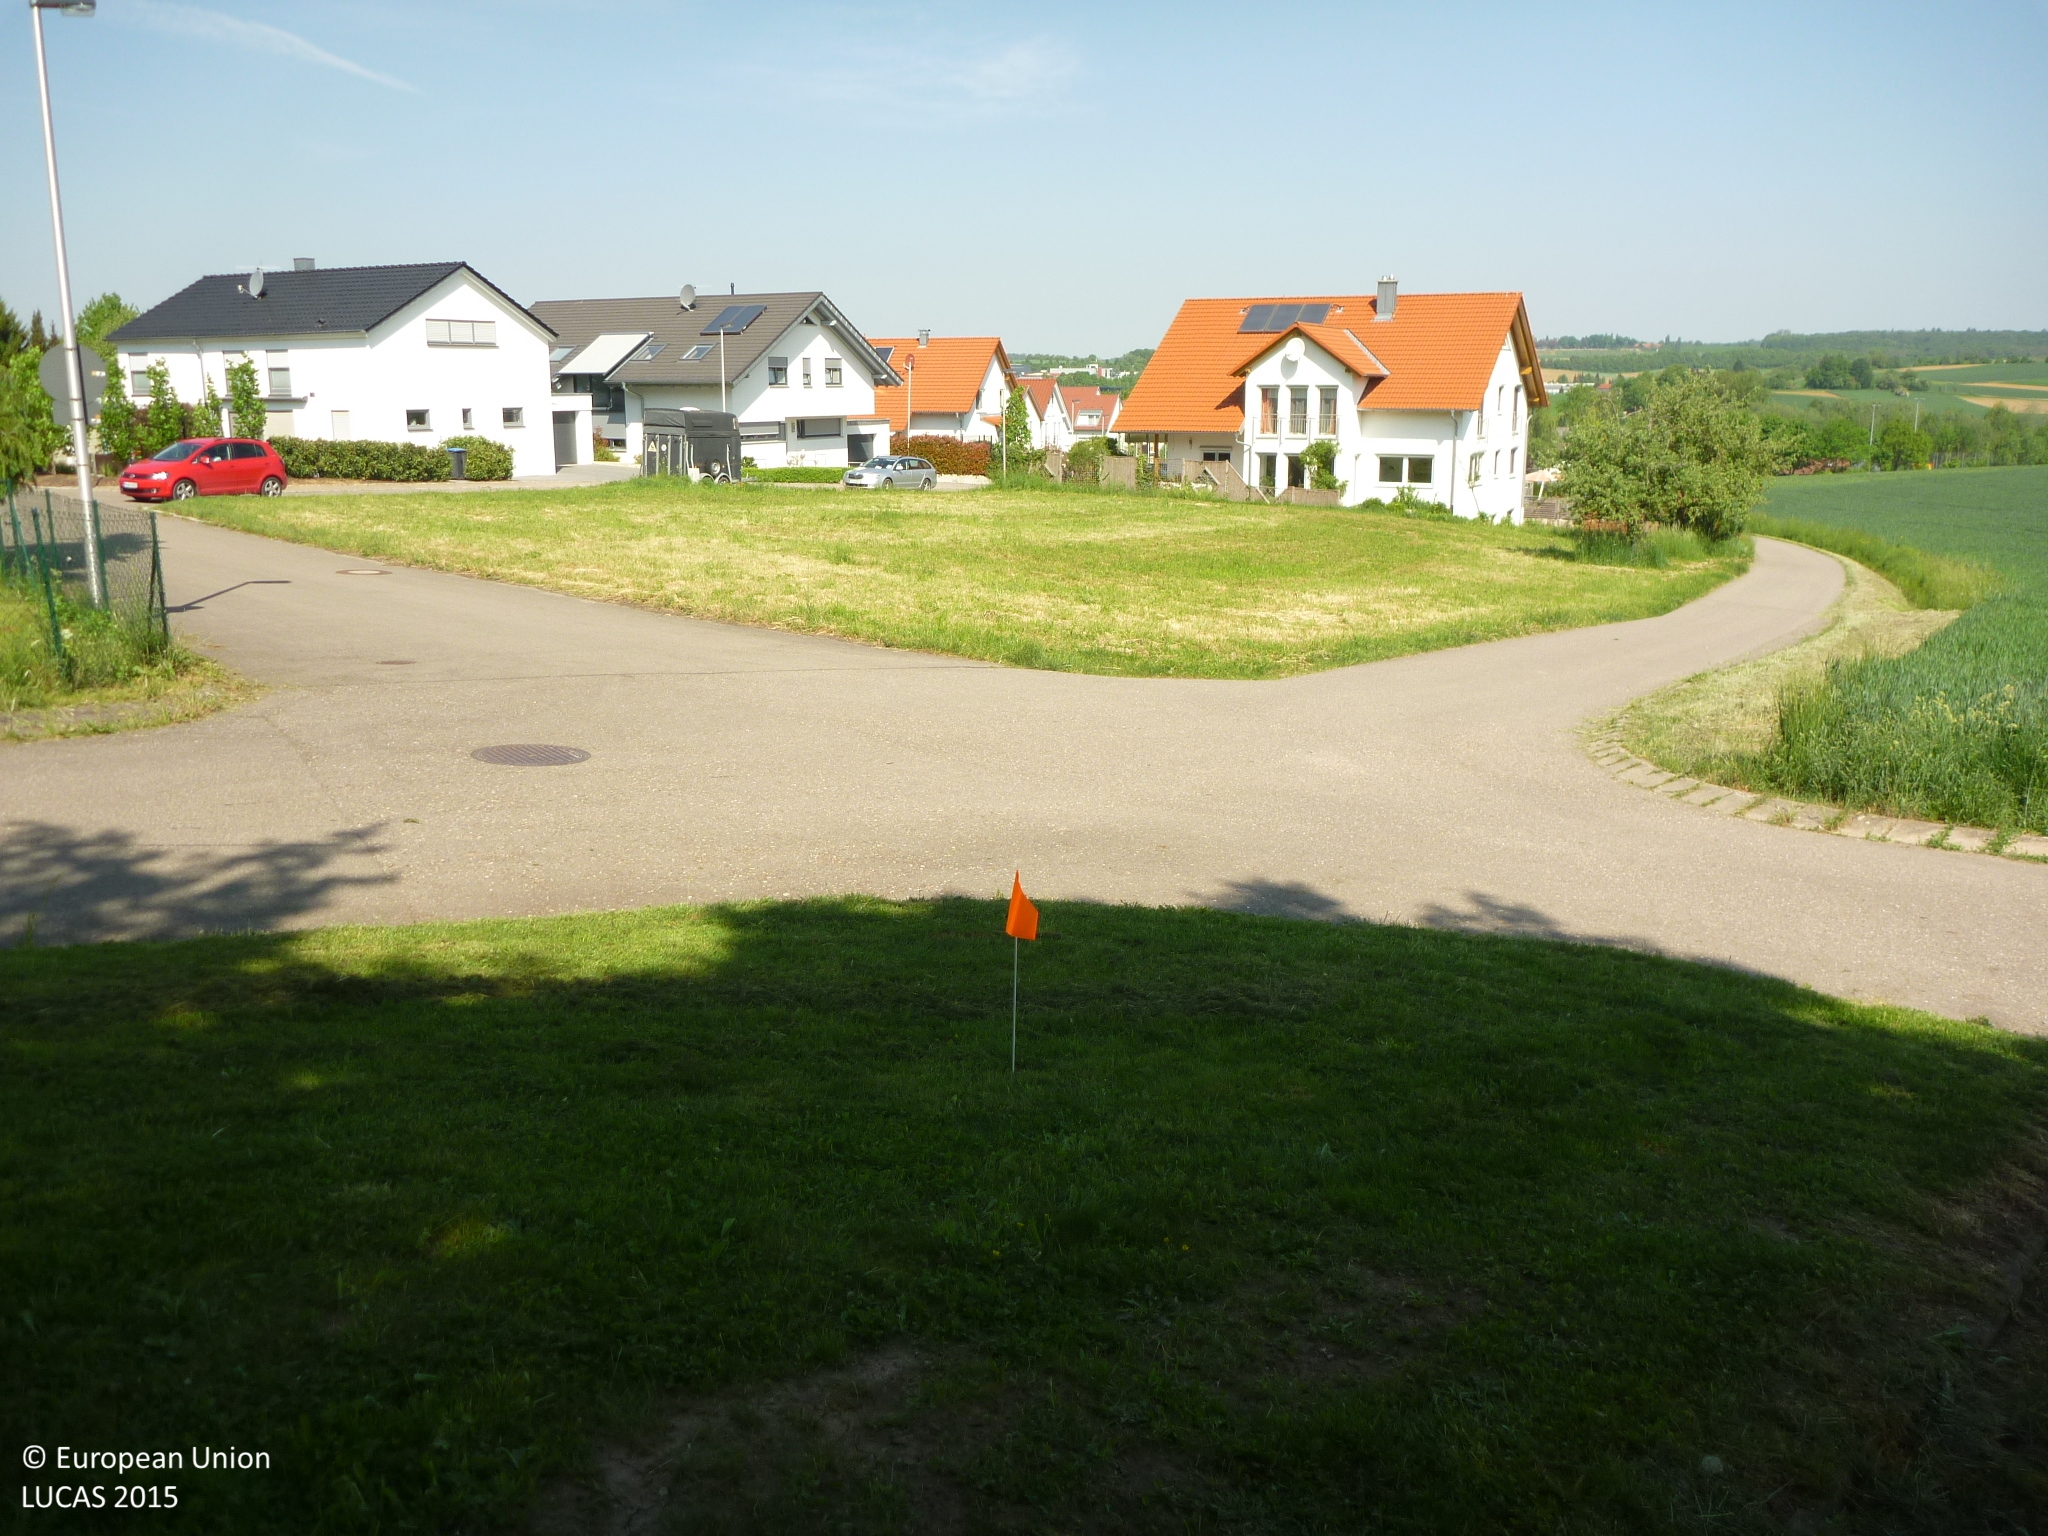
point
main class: Grassland
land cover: Grassland without tree/shrub cover
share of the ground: > 75 %
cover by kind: herbaceous plants 100 %
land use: Community services
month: May
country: DE
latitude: 49.0670
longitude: 9.3023
